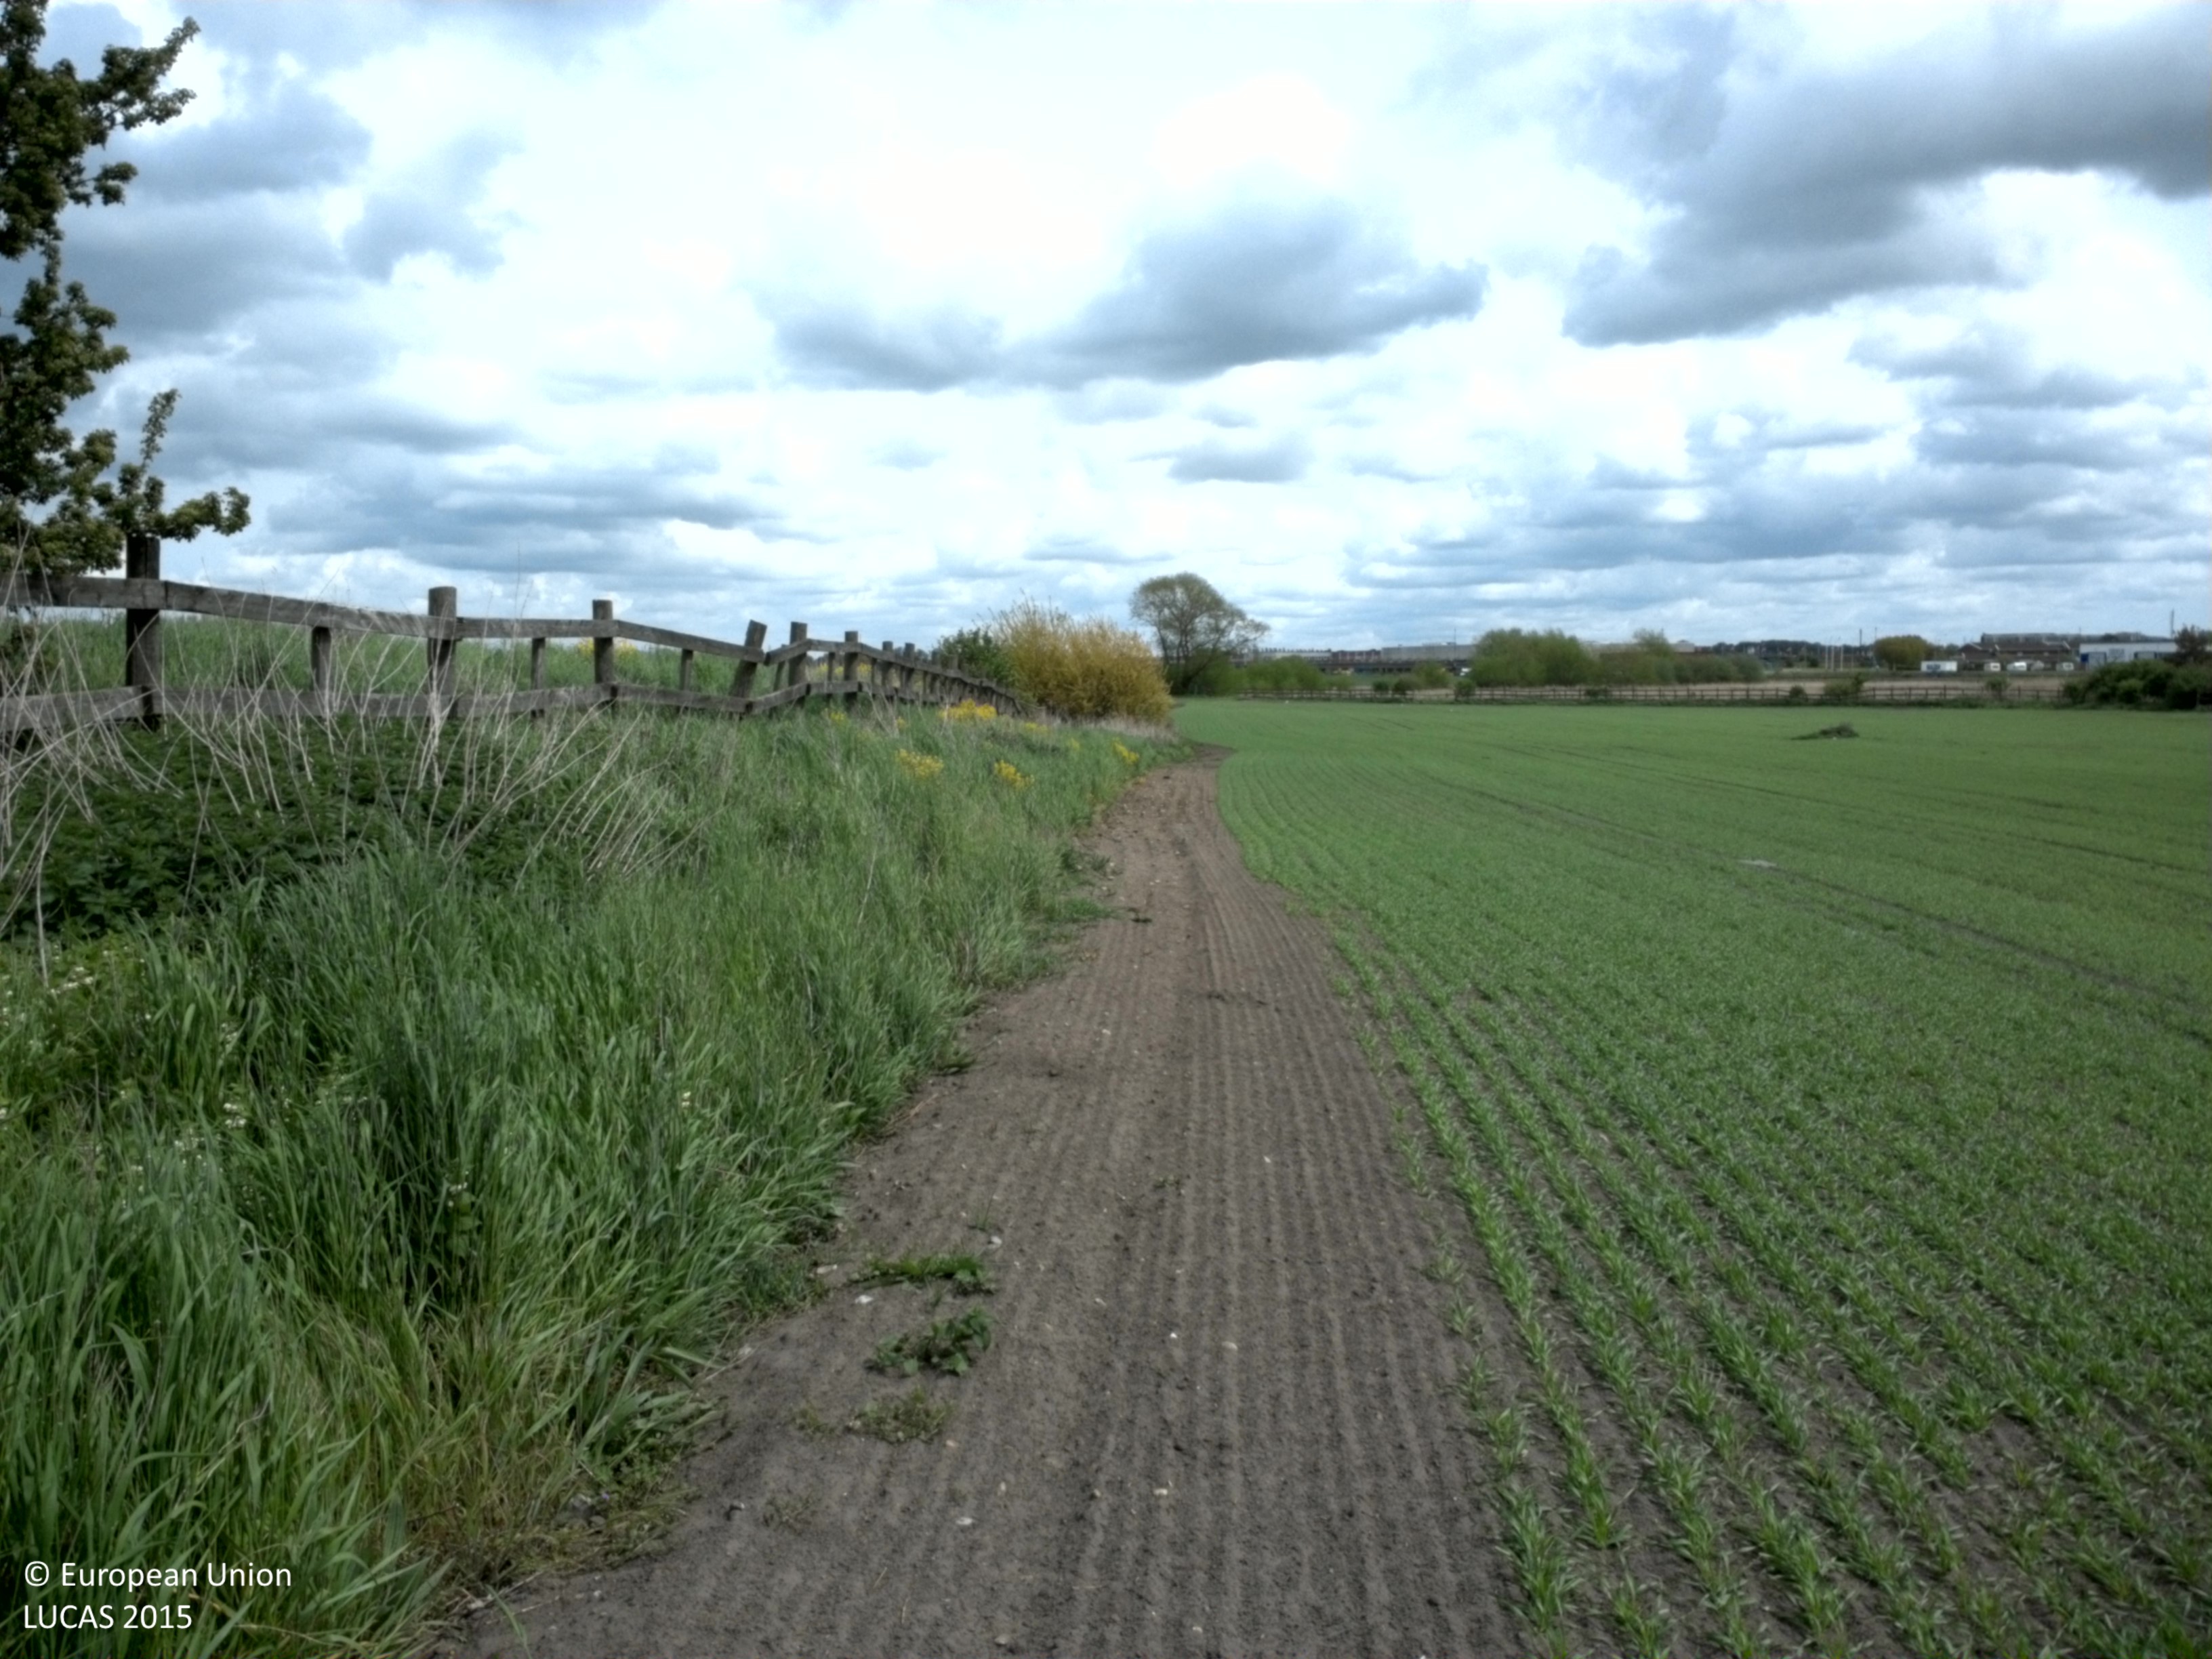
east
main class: Cropland
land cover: Barley
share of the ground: > 75 %
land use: Agriculture (excluding fallow land and kitchen gardens)
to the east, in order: Barley; Single bushes/trees; Fences; Grass margins; Paved roads, cycling and walking lanes; Barley; Sugar beet
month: May
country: SE
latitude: 55.6475
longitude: 13.0648
